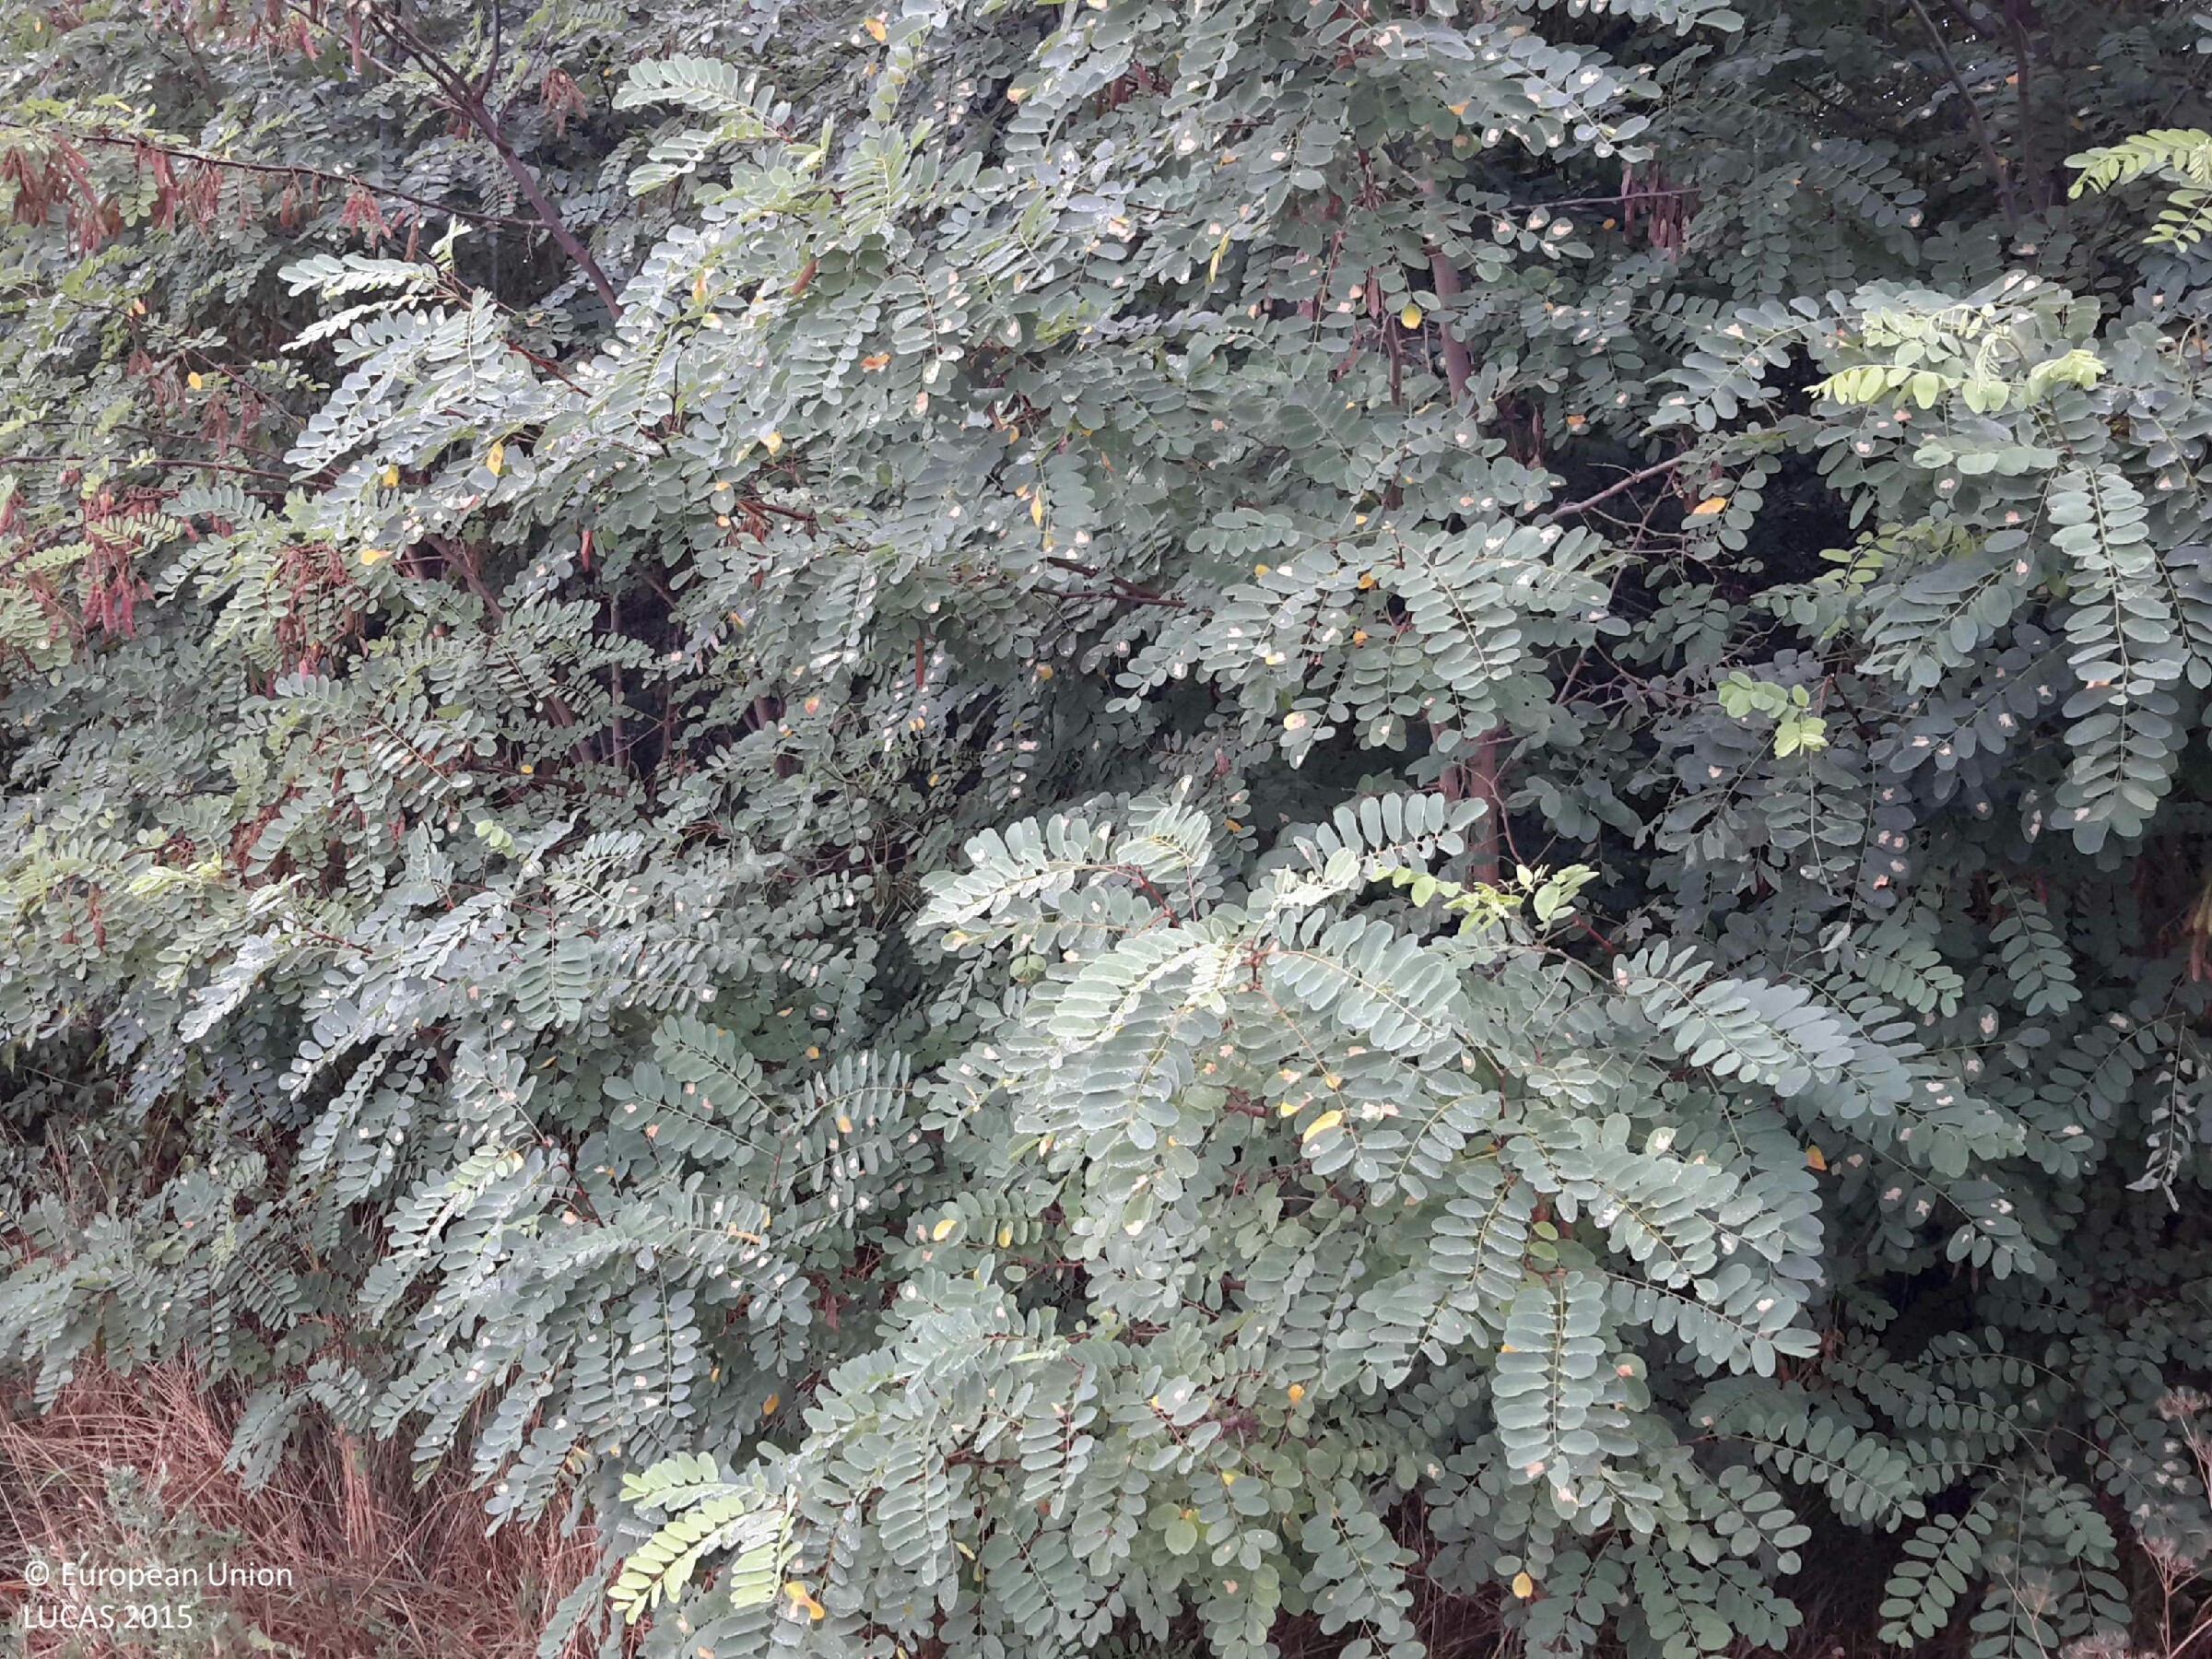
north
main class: Shrubland
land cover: Shrubland without tree cover
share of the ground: > 75 %
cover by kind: shrubs 100 %
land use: Forestry
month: July
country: HU
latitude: 47.4634
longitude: 17.4766
